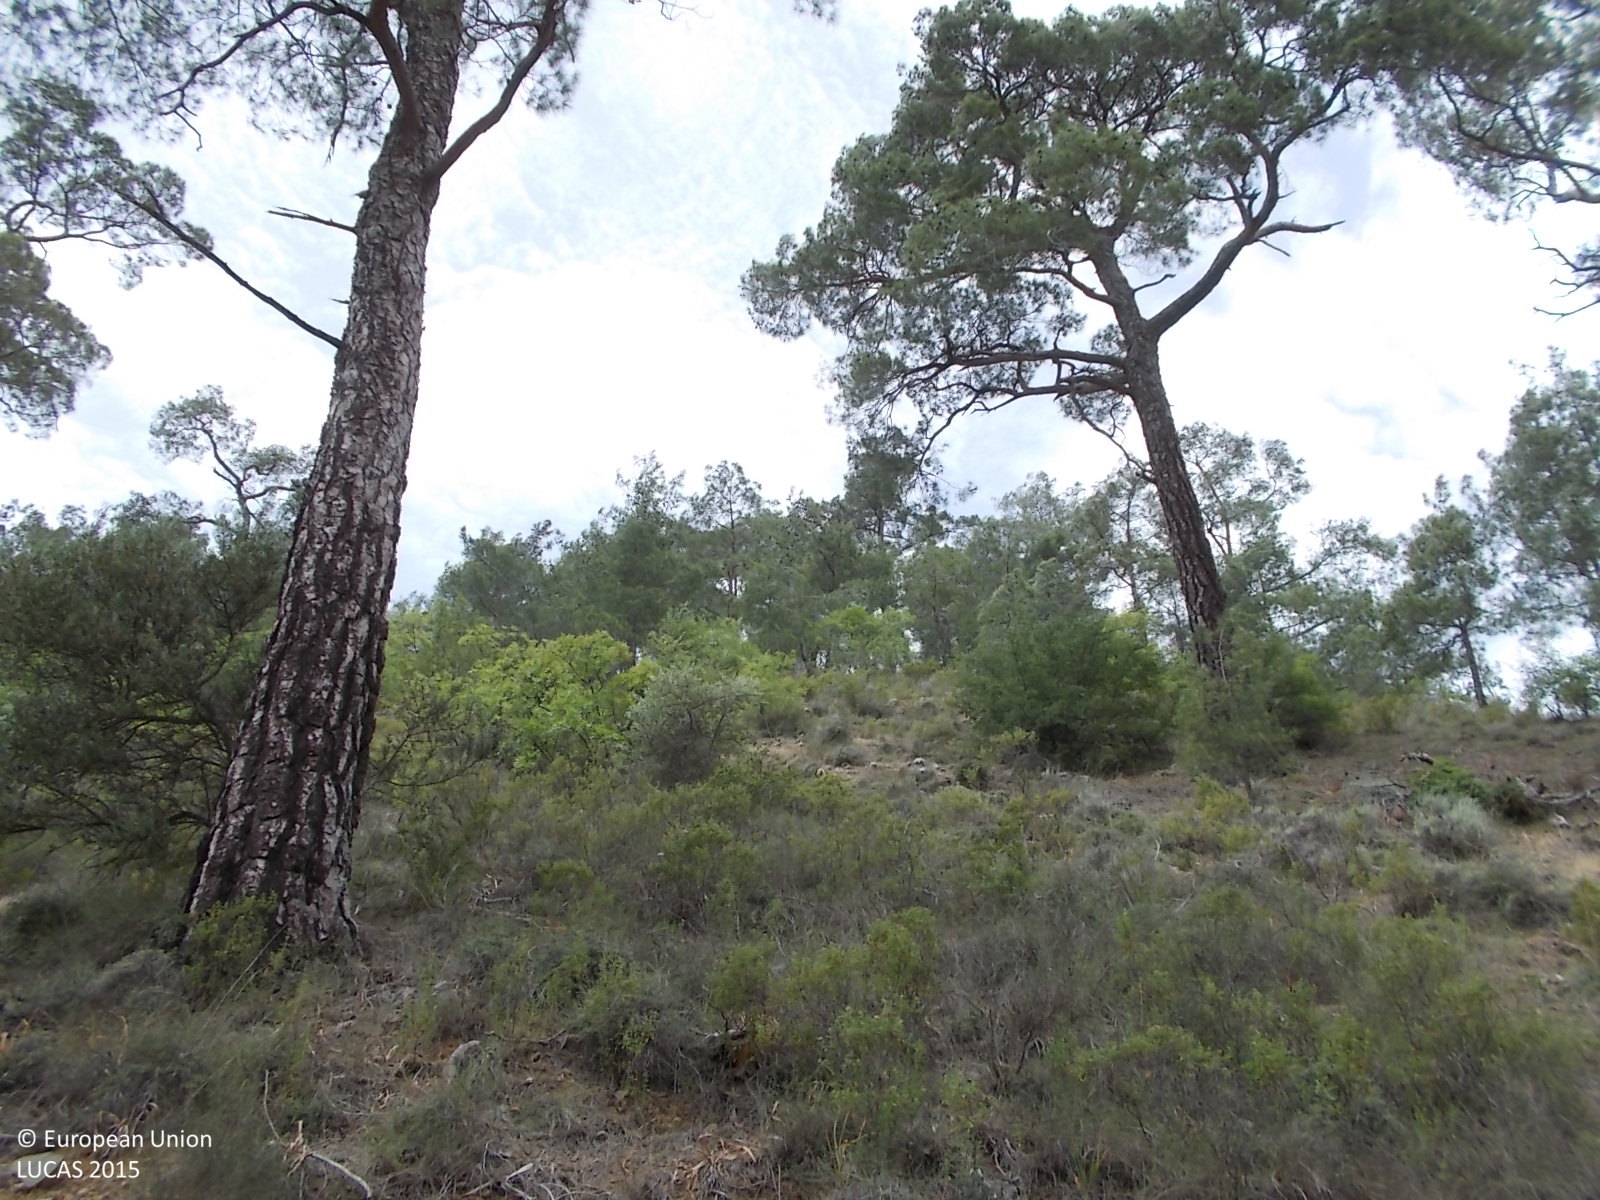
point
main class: Woodland
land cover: Pine dominated coniferous woodland
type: coniferous forest of the mediterranean region
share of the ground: > 75 %
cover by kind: coniferous forest trees 90 %, shrubs 10 %
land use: Semi-natural and natural areas not in use
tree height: > 5 m
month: May
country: CY
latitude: 34.9529
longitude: 32.5944
